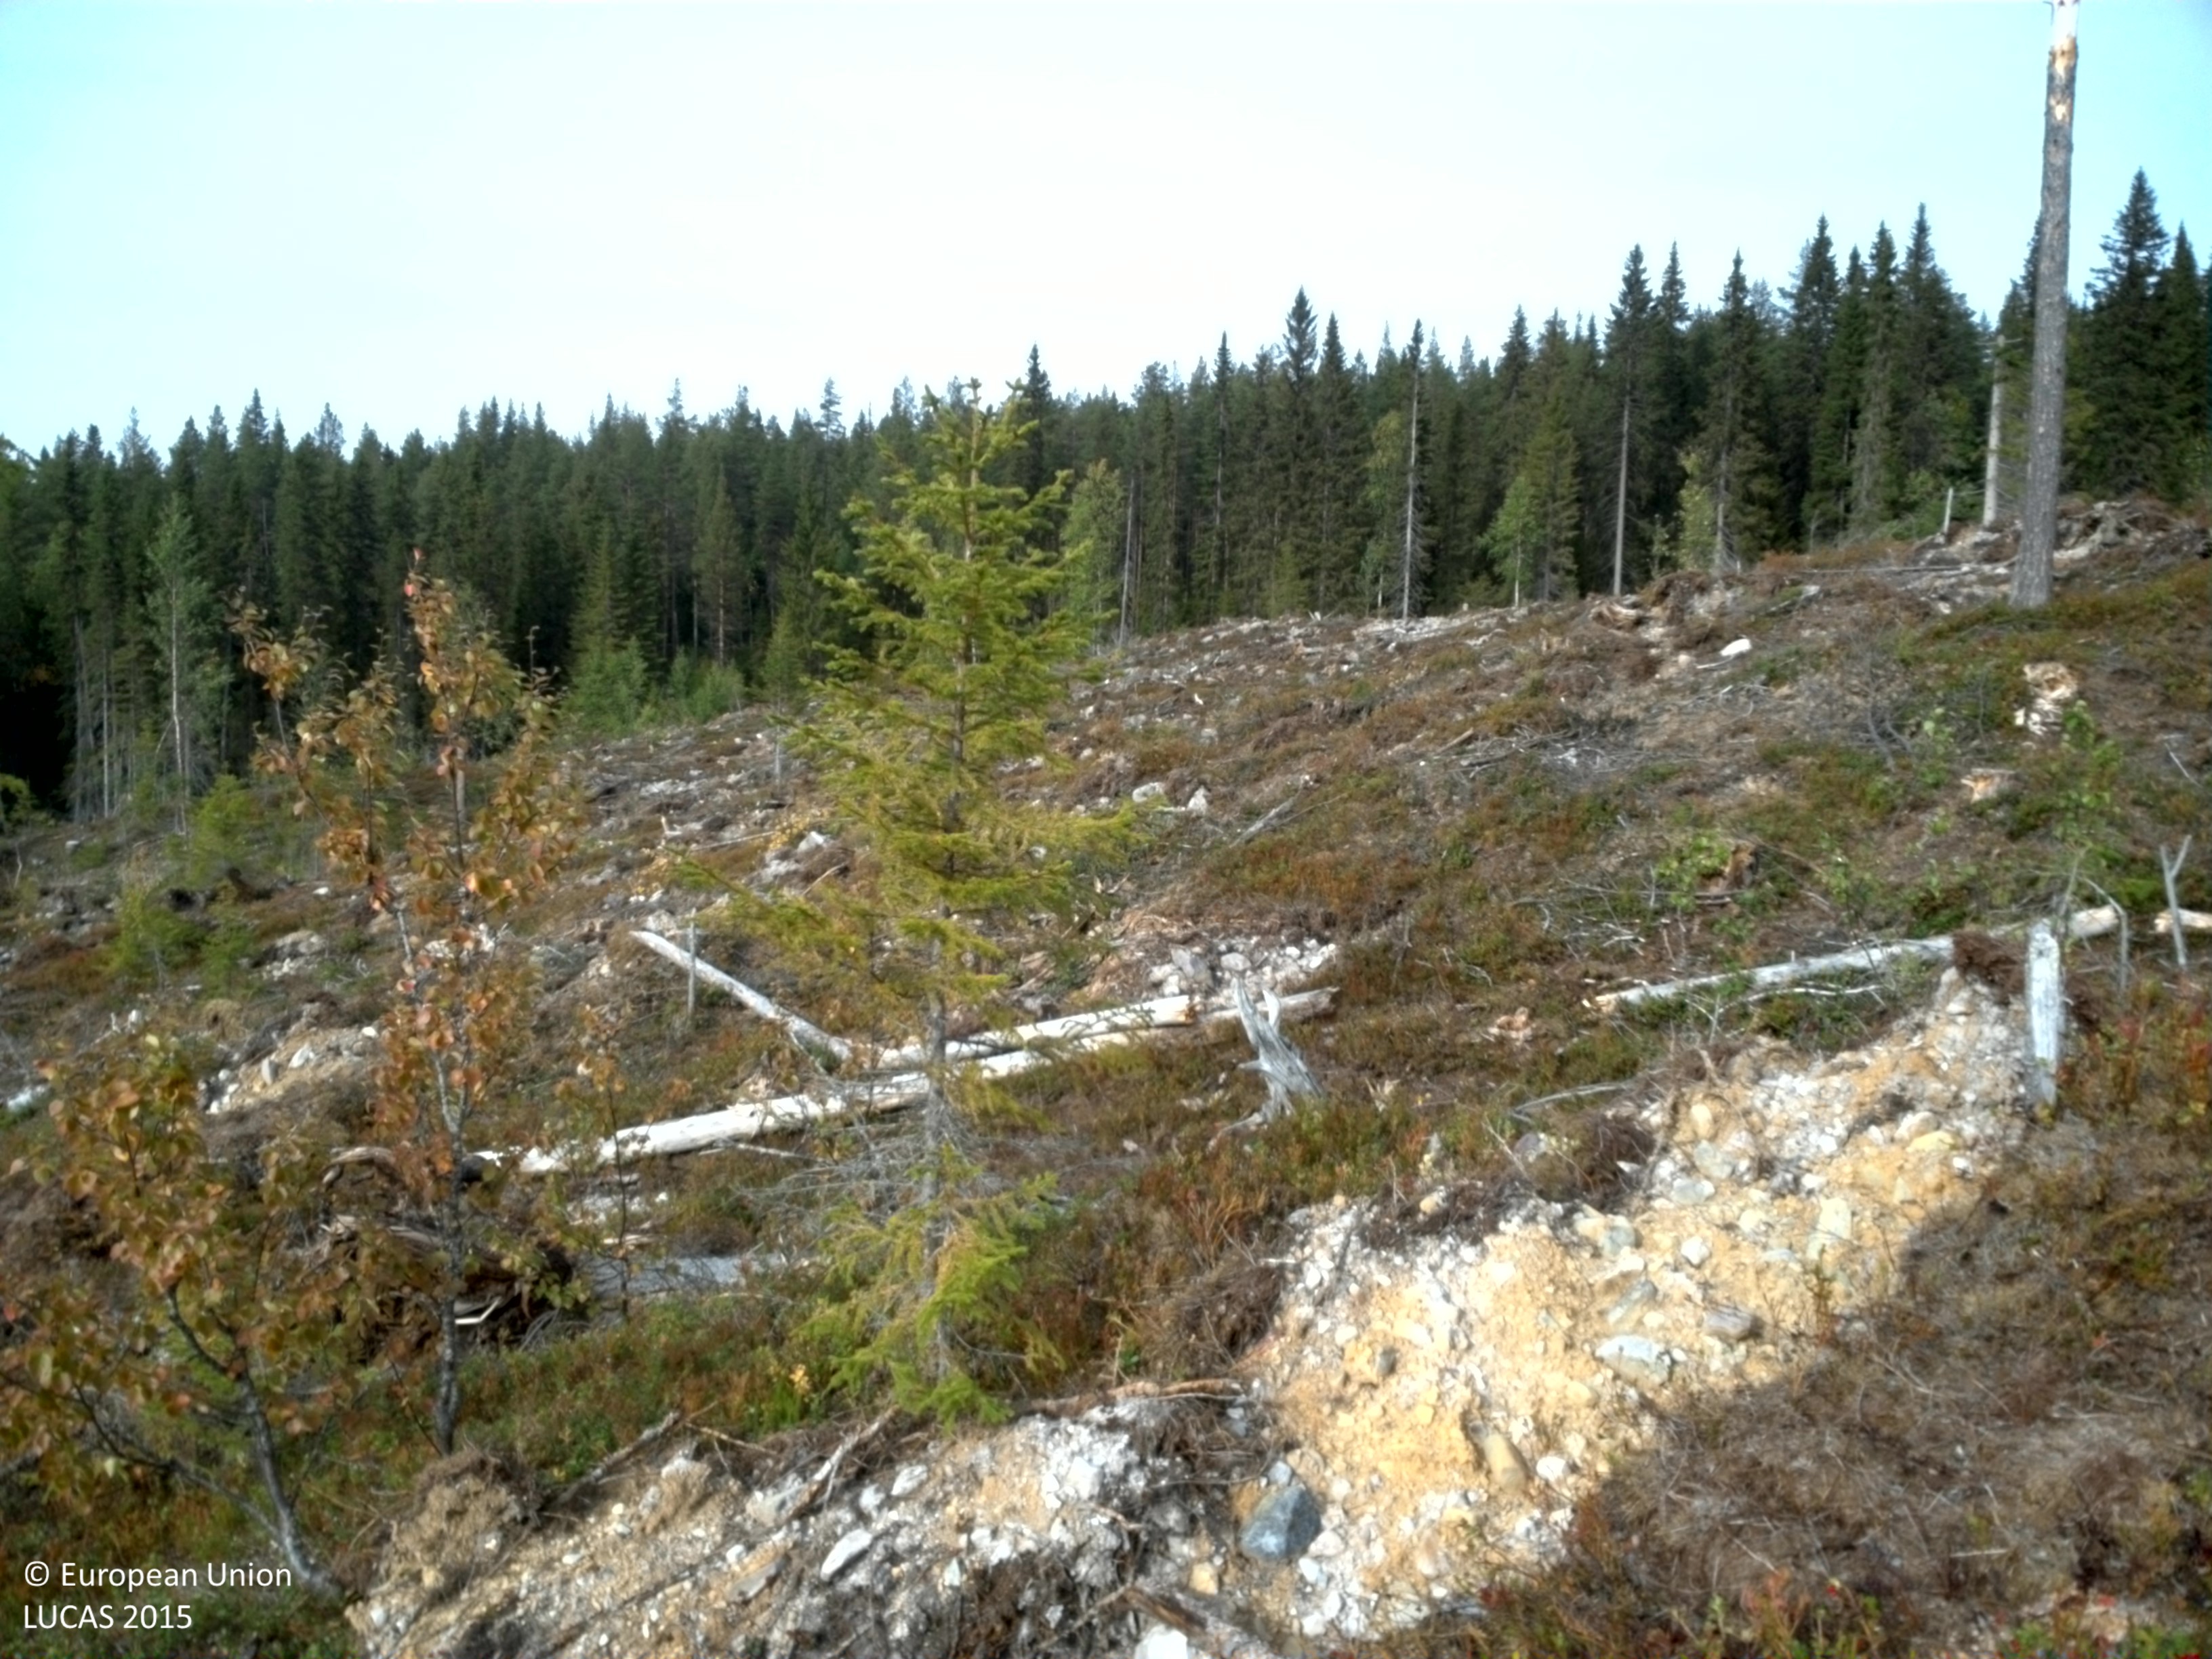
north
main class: Shrubland
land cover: Shrubland with sparse tree cover
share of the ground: 10 - 25 %
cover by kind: unconsolidated bare surface 55 %, shrubs 20 %, coniferous forest trees 5 %, herbaceous plants 5 %, lichens and mosses 5 %, consolidated bare surface 5 %
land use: Forestry
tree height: < 5 m
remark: Clear cut
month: September
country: SE
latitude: 65.3652
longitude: 16.6486
